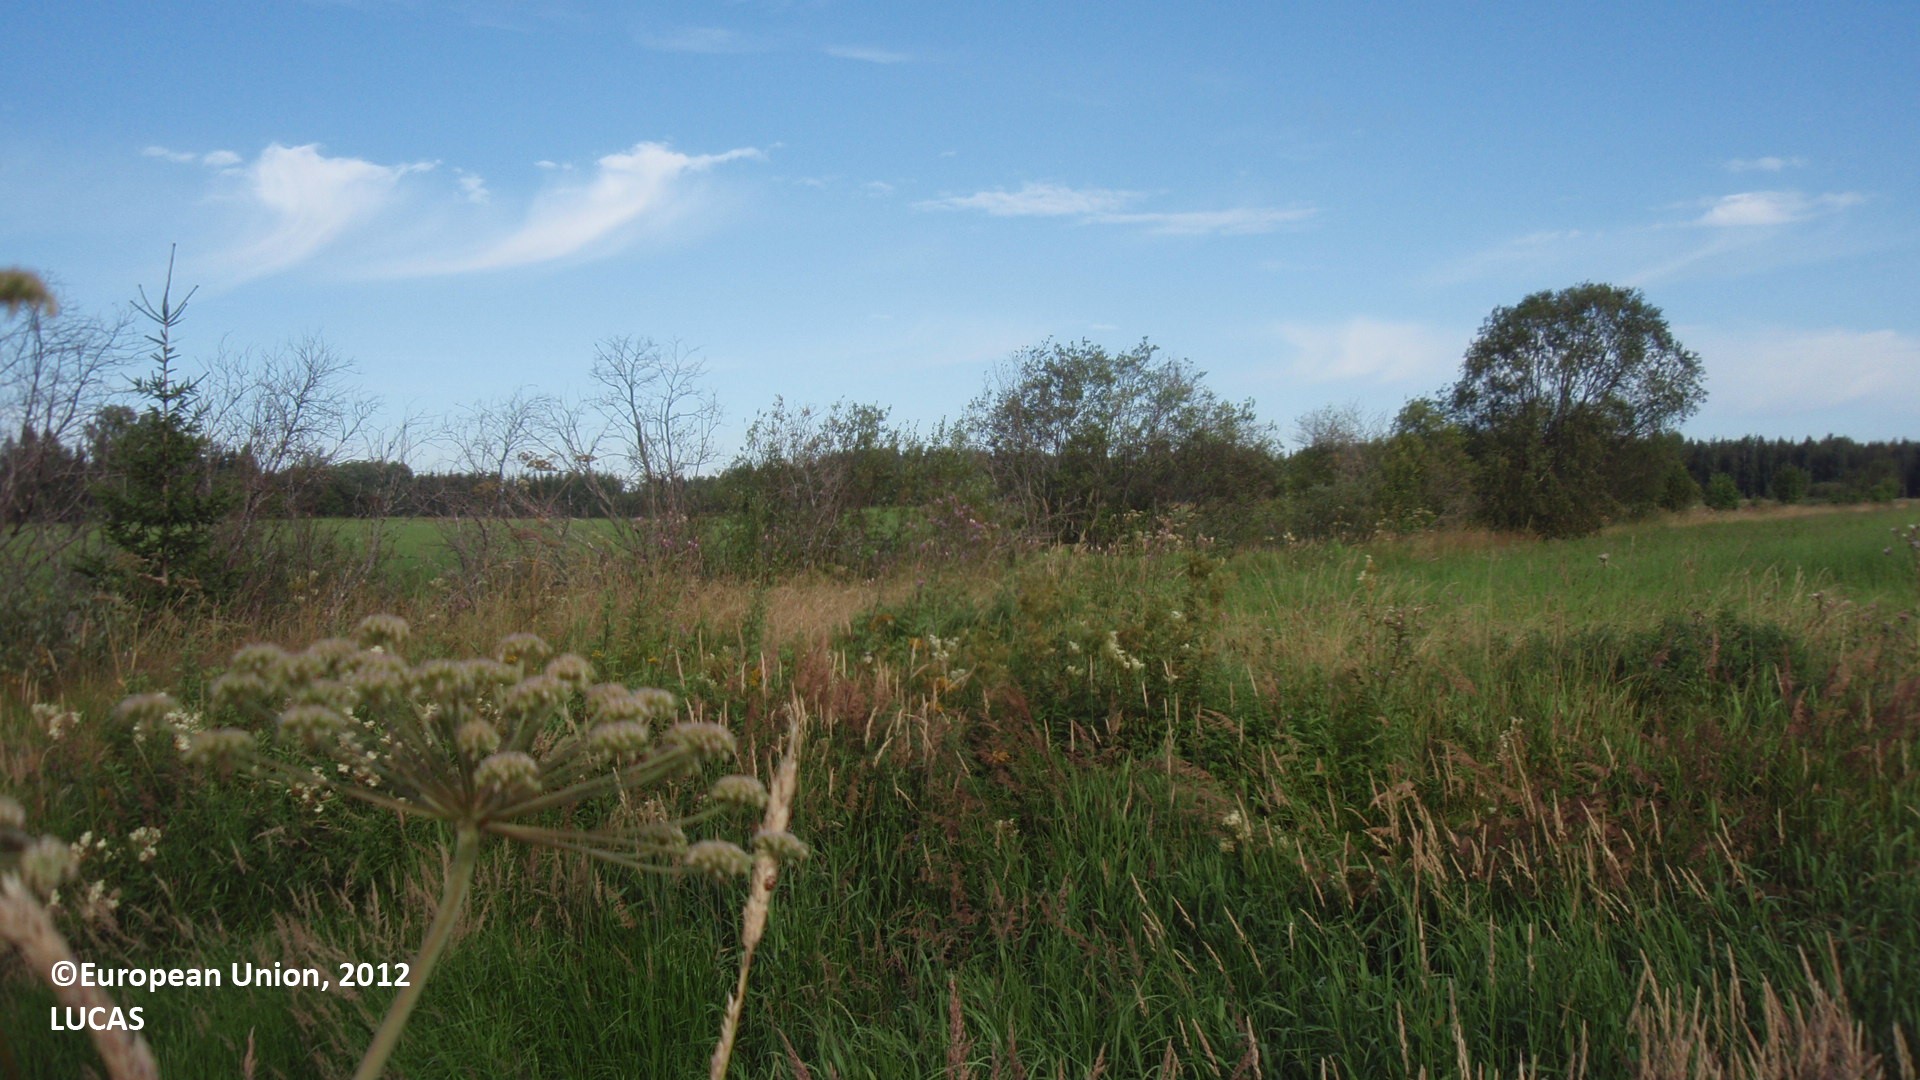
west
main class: Cropland
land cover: Mixed cereals for fodder
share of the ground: > 75 %
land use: Agriculture (excluding fallow land and kitchen gardens)
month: August
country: FI
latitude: 61.2134
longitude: 28.0128
